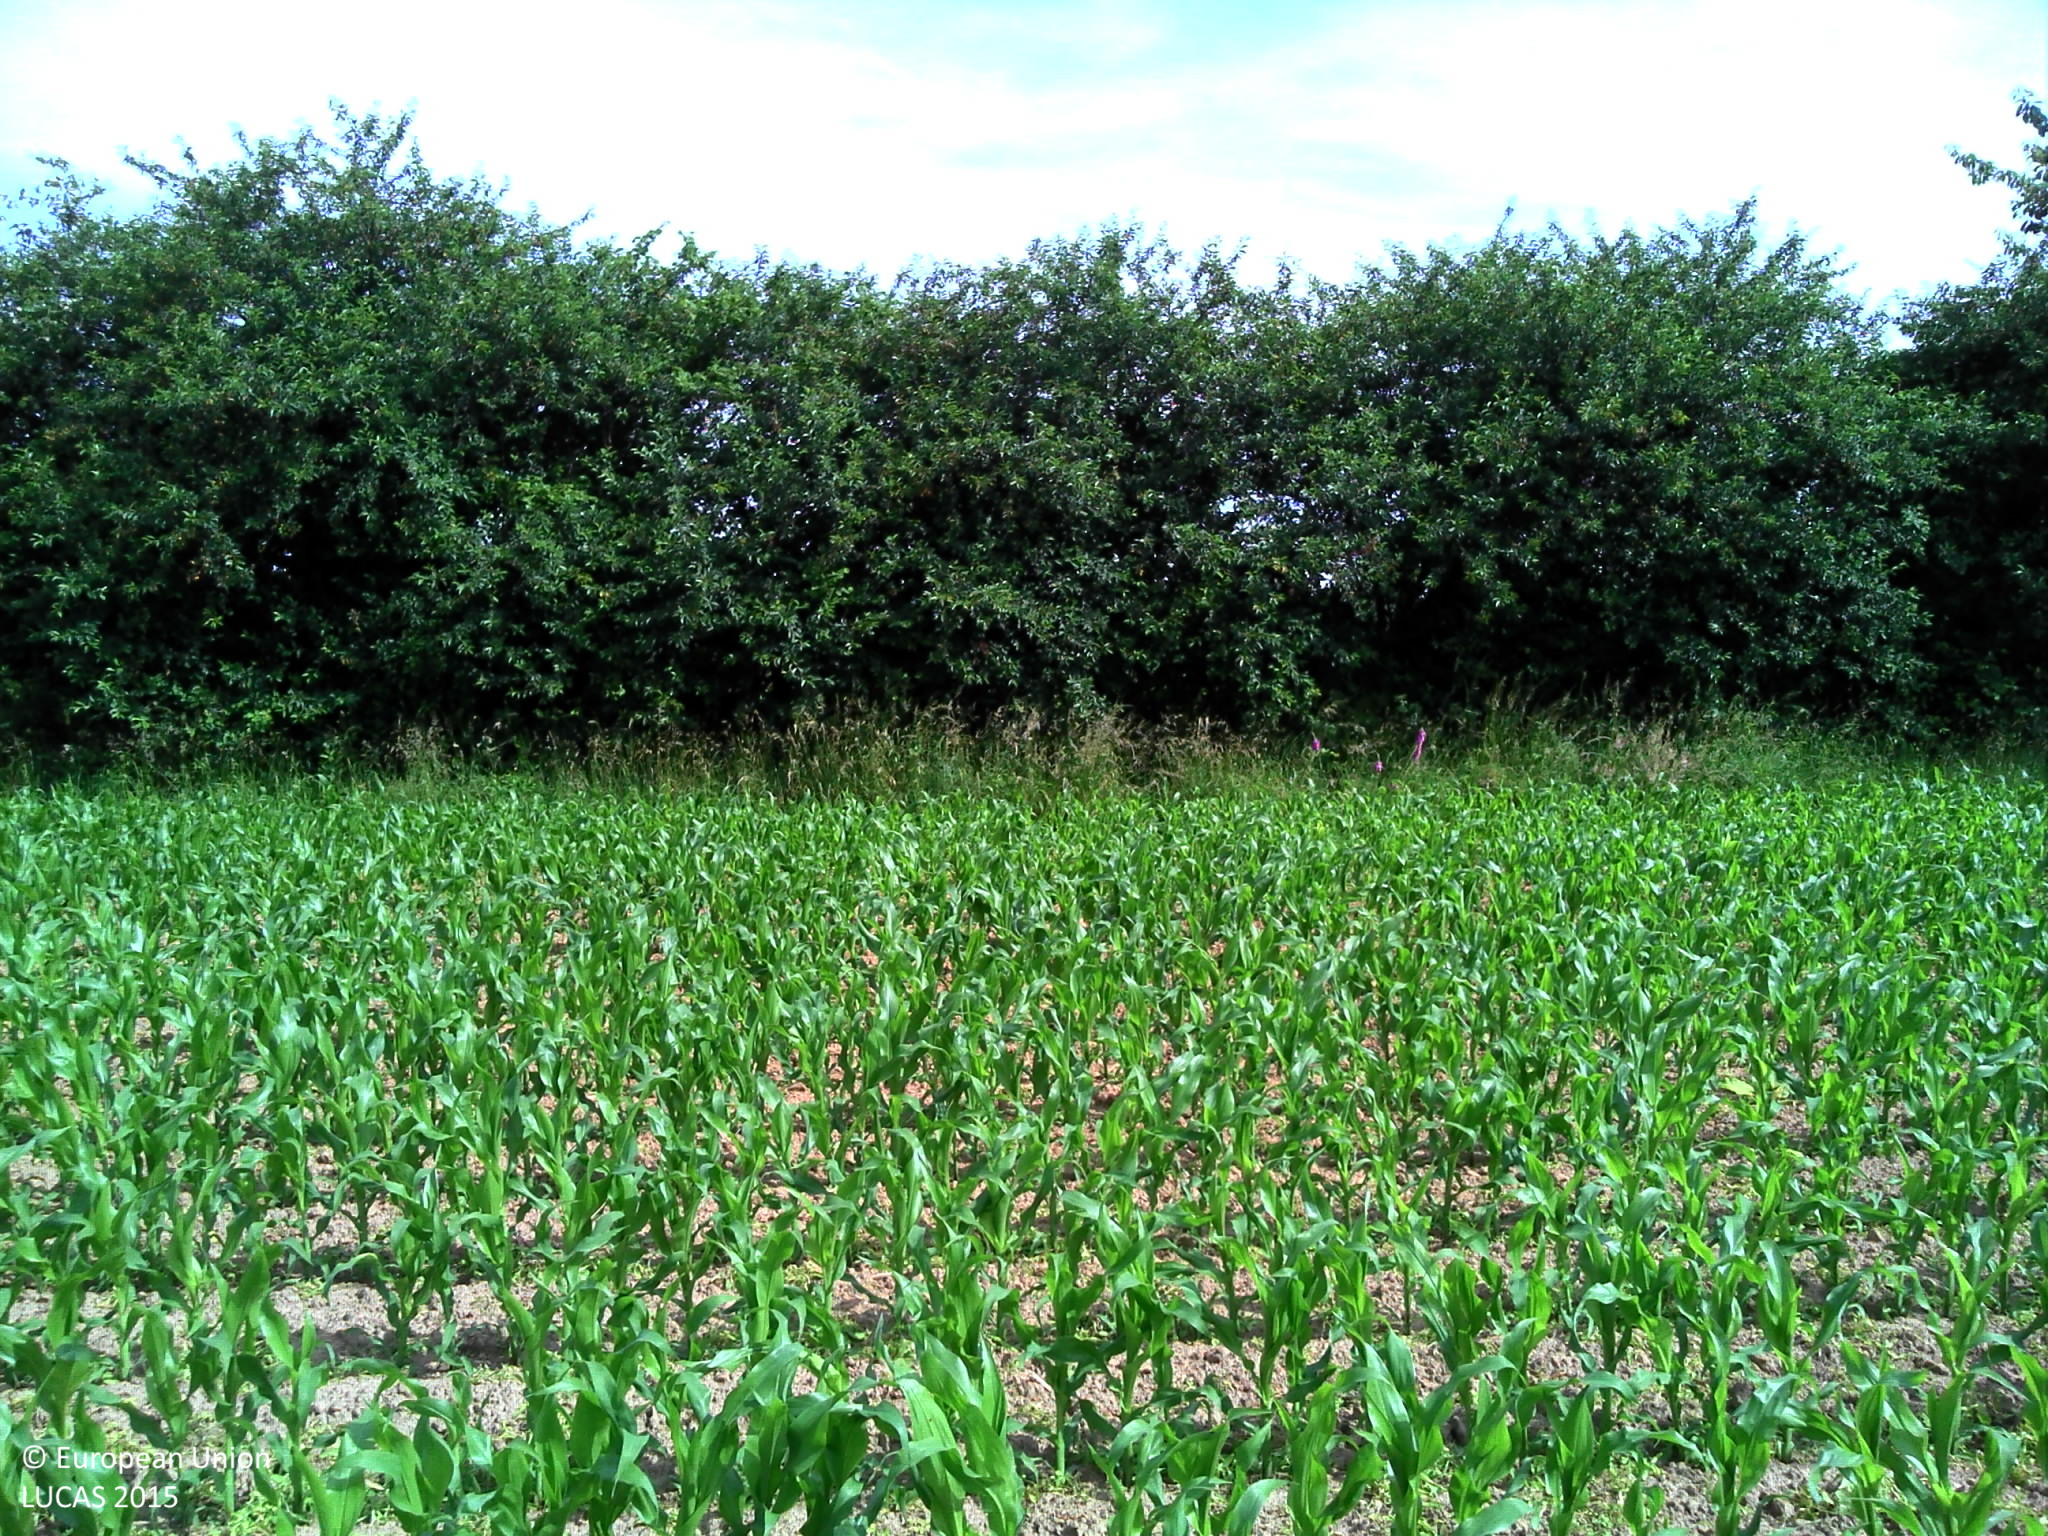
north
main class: Cropland
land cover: Maize
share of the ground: 25 - 50 %
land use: Agriculture (excluding fallow land and kitchen gardens)
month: June
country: FR
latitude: 49.2107
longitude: -1.3998
